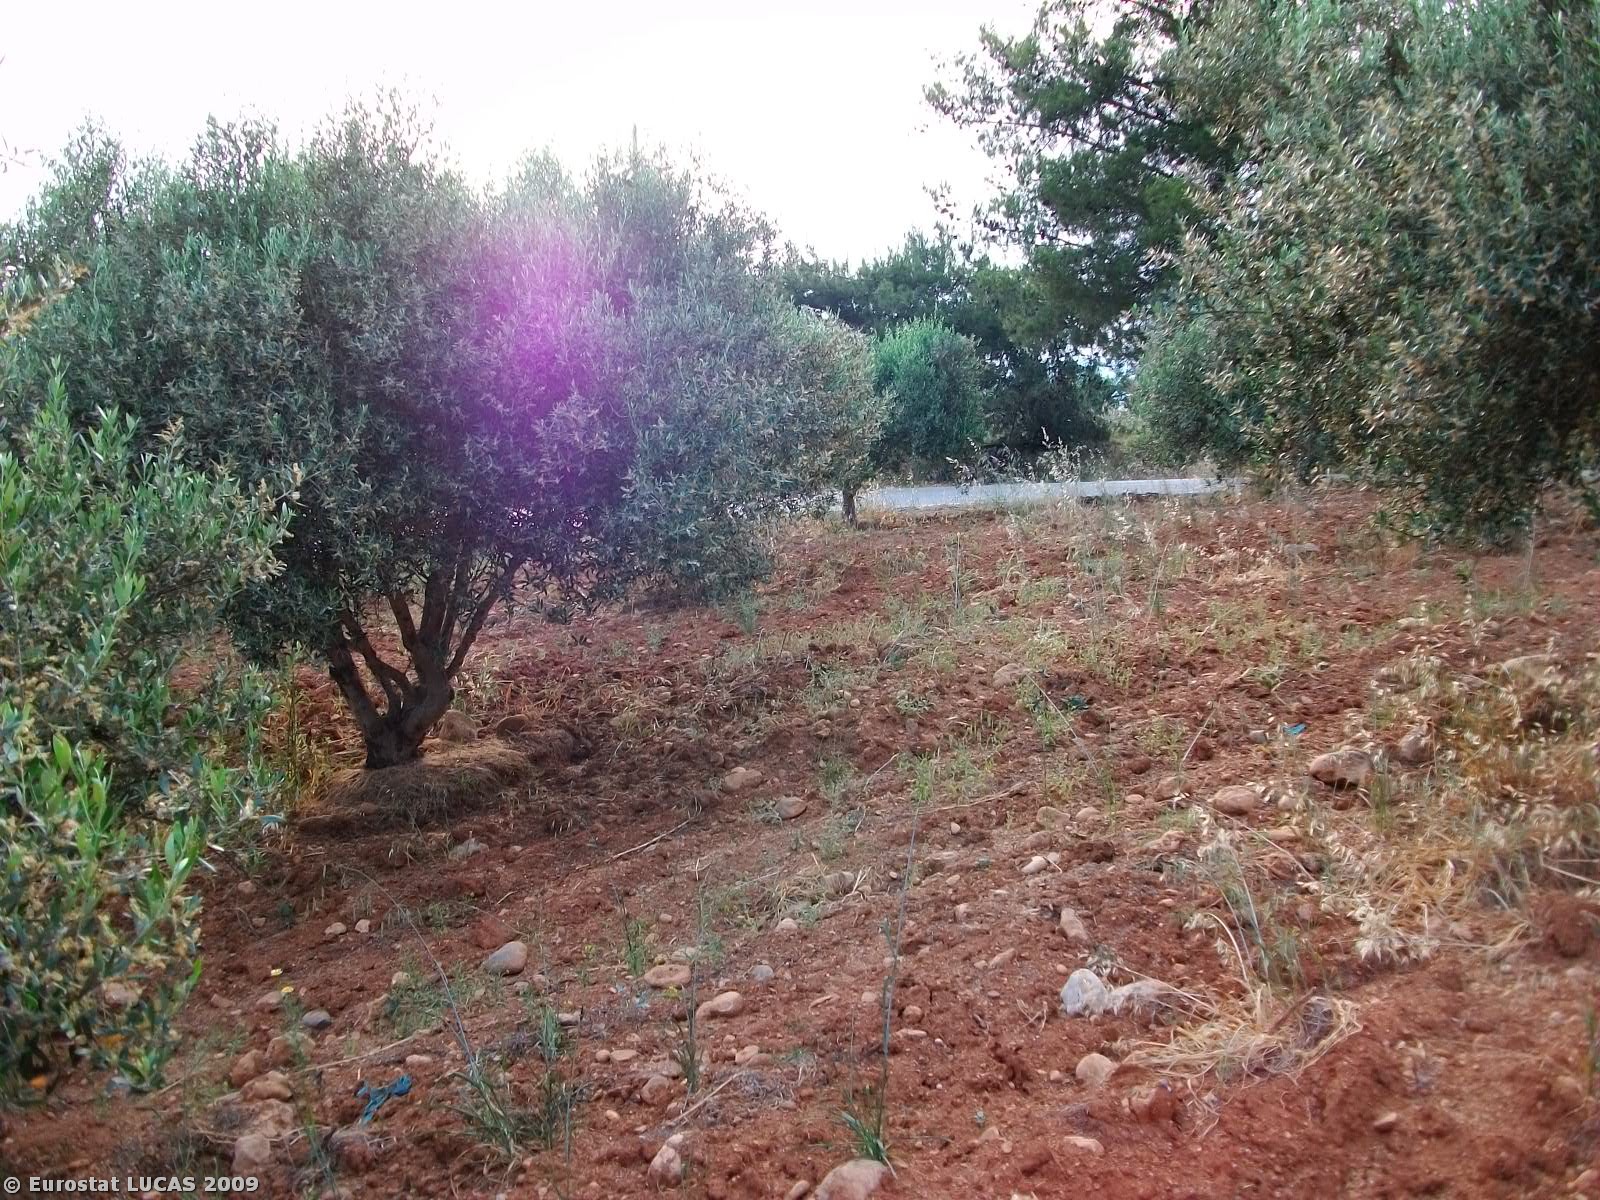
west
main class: Cropland
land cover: Olive groves
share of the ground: 50 - 75 %
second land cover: Bare land
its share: > 75 %
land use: Agriculture (excluding fallow land and kitchen gardens)
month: June
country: GR
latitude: 35.0479
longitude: 25.0609
